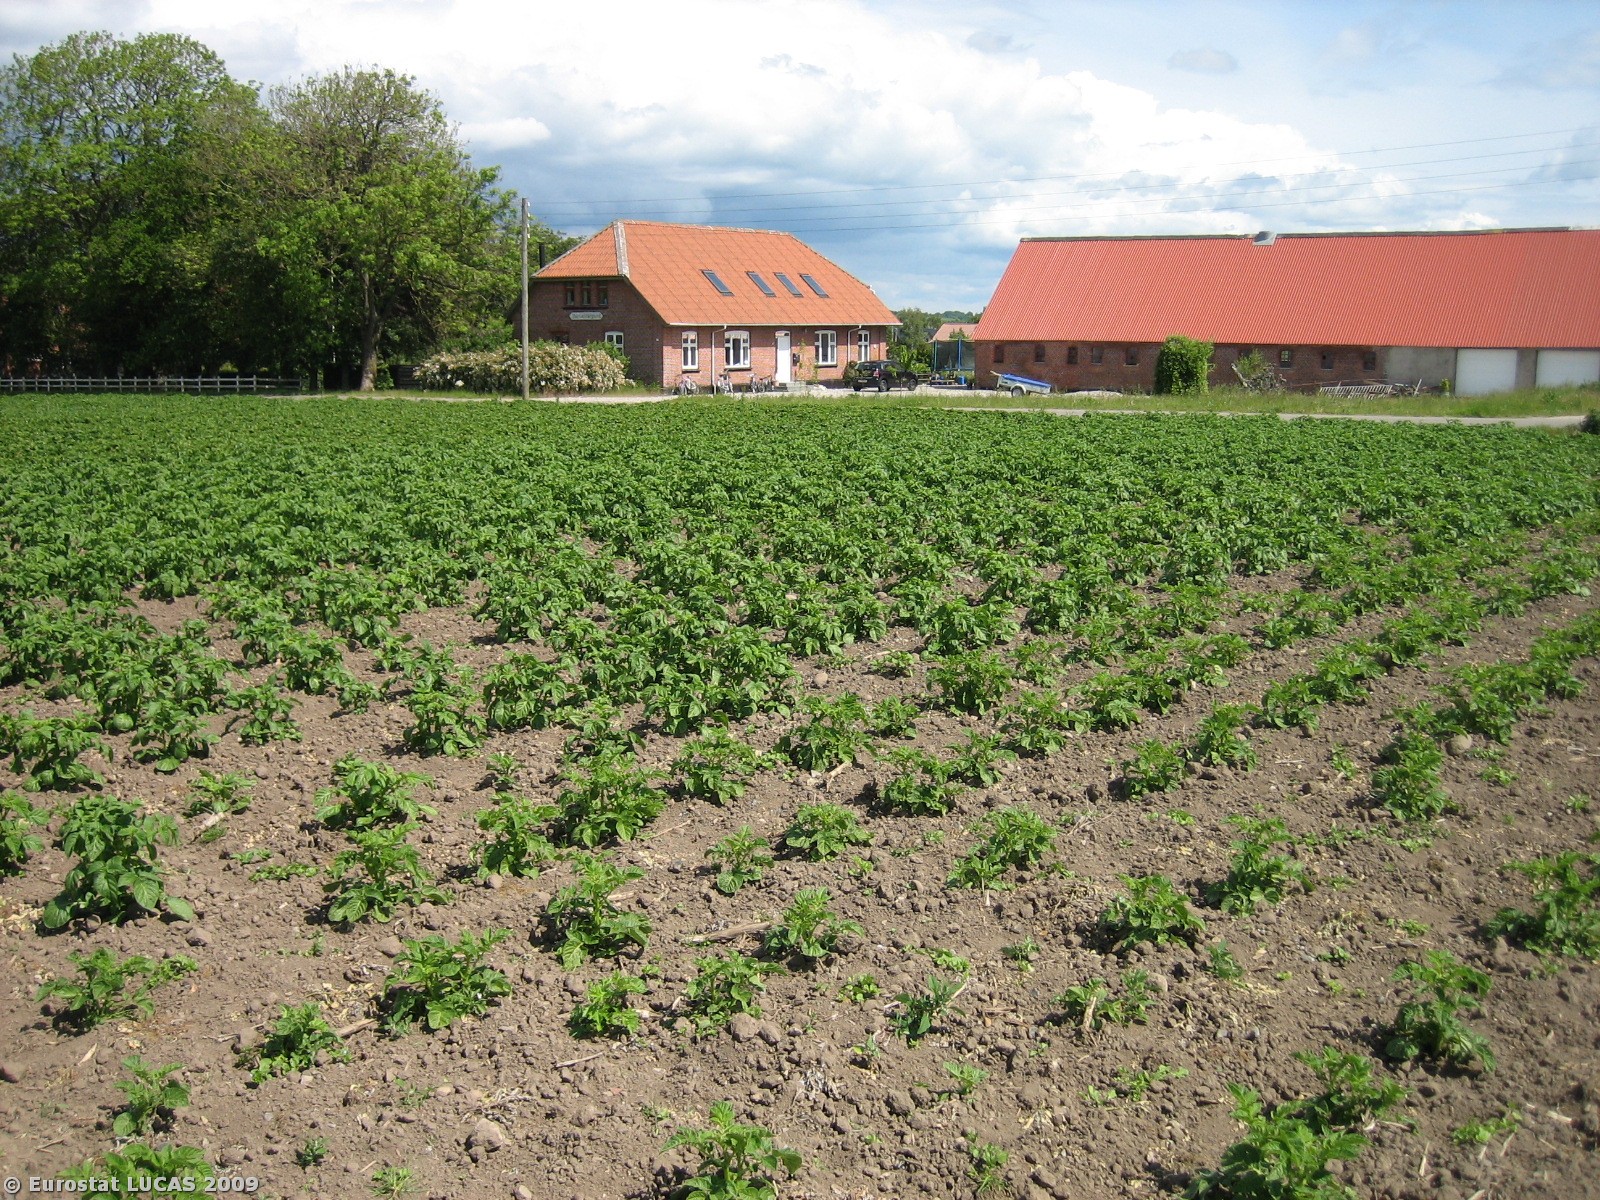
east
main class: Cropland
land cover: Barley
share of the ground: > 75 %
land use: Agriculture (excluding fallow land and kitchen gardens)
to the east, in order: Barley; Grass margins; Potatoes; Grass margins; Paved roads, cycling and walking lanes; Grass margins; Shrubland without tree cover; Artificial constructions in urban areas; Single bushes/trees; Fences; Arable land (only in case pi); Fences; Grassland without tree/shrub cover; Fences; Arable land (only in case pi); Common wheat
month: June
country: DK
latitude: 56.2954
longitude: 9.7902
